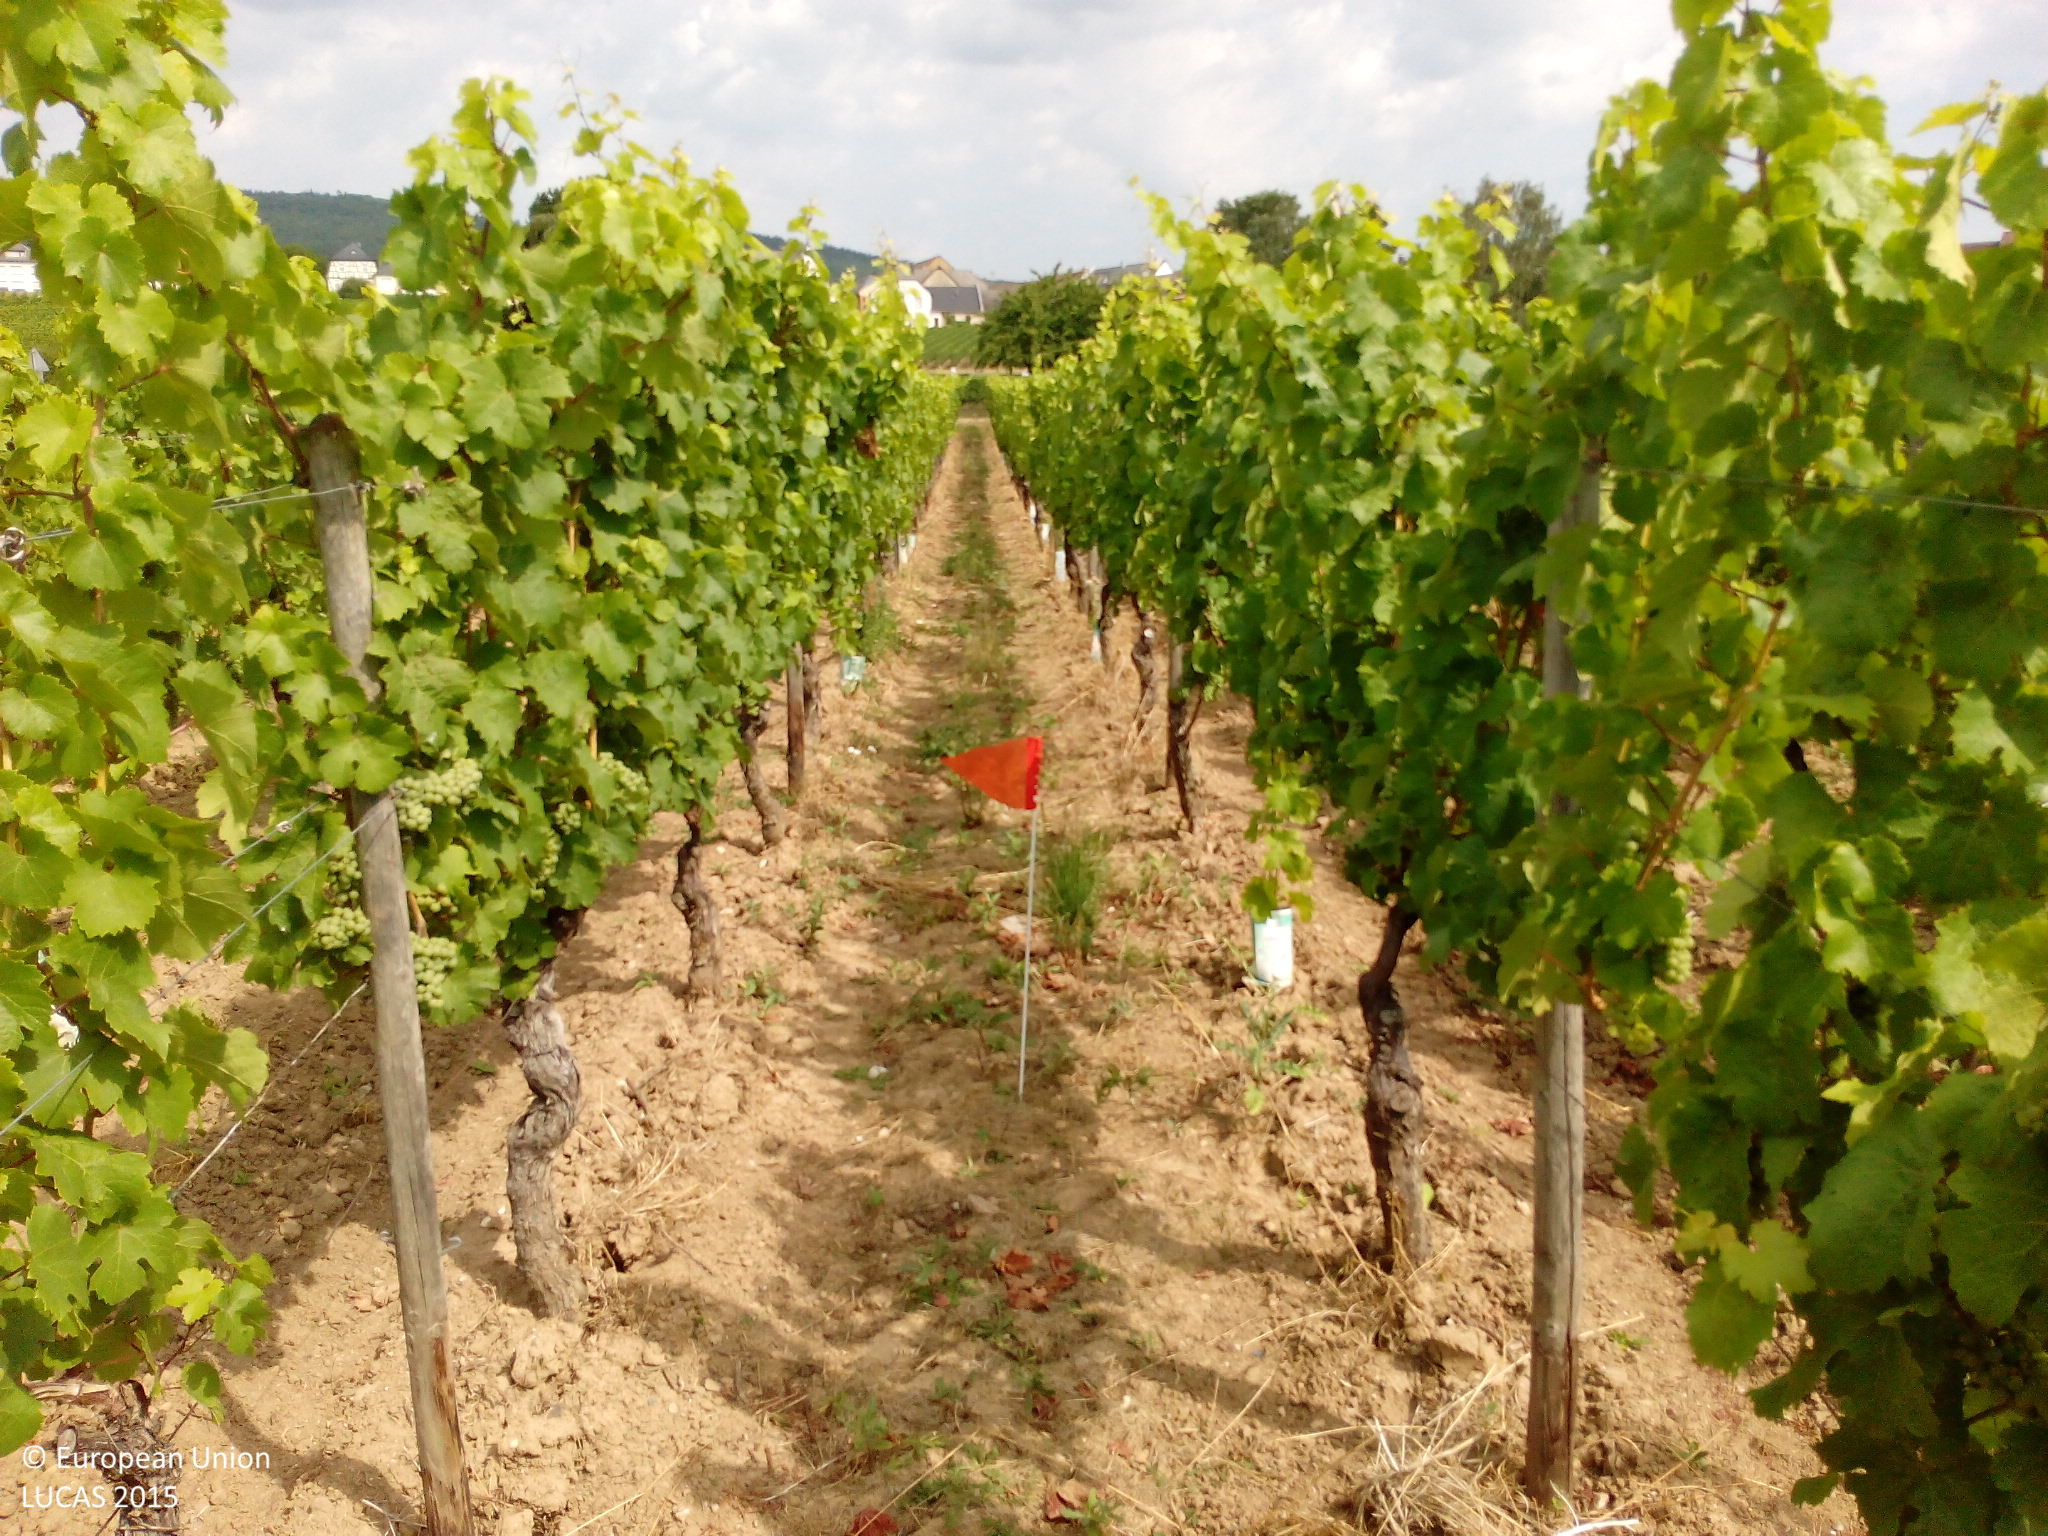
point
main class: Cropland
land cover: Vineyards
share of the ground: 25 - 50 %
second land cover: Spontaneously vegetated surfaces
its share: 10 - 25 %
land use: Agriculture (excluding fallow land and kitchen gardens)
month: August
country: DE
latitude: 50.0234
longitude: 8.0323
